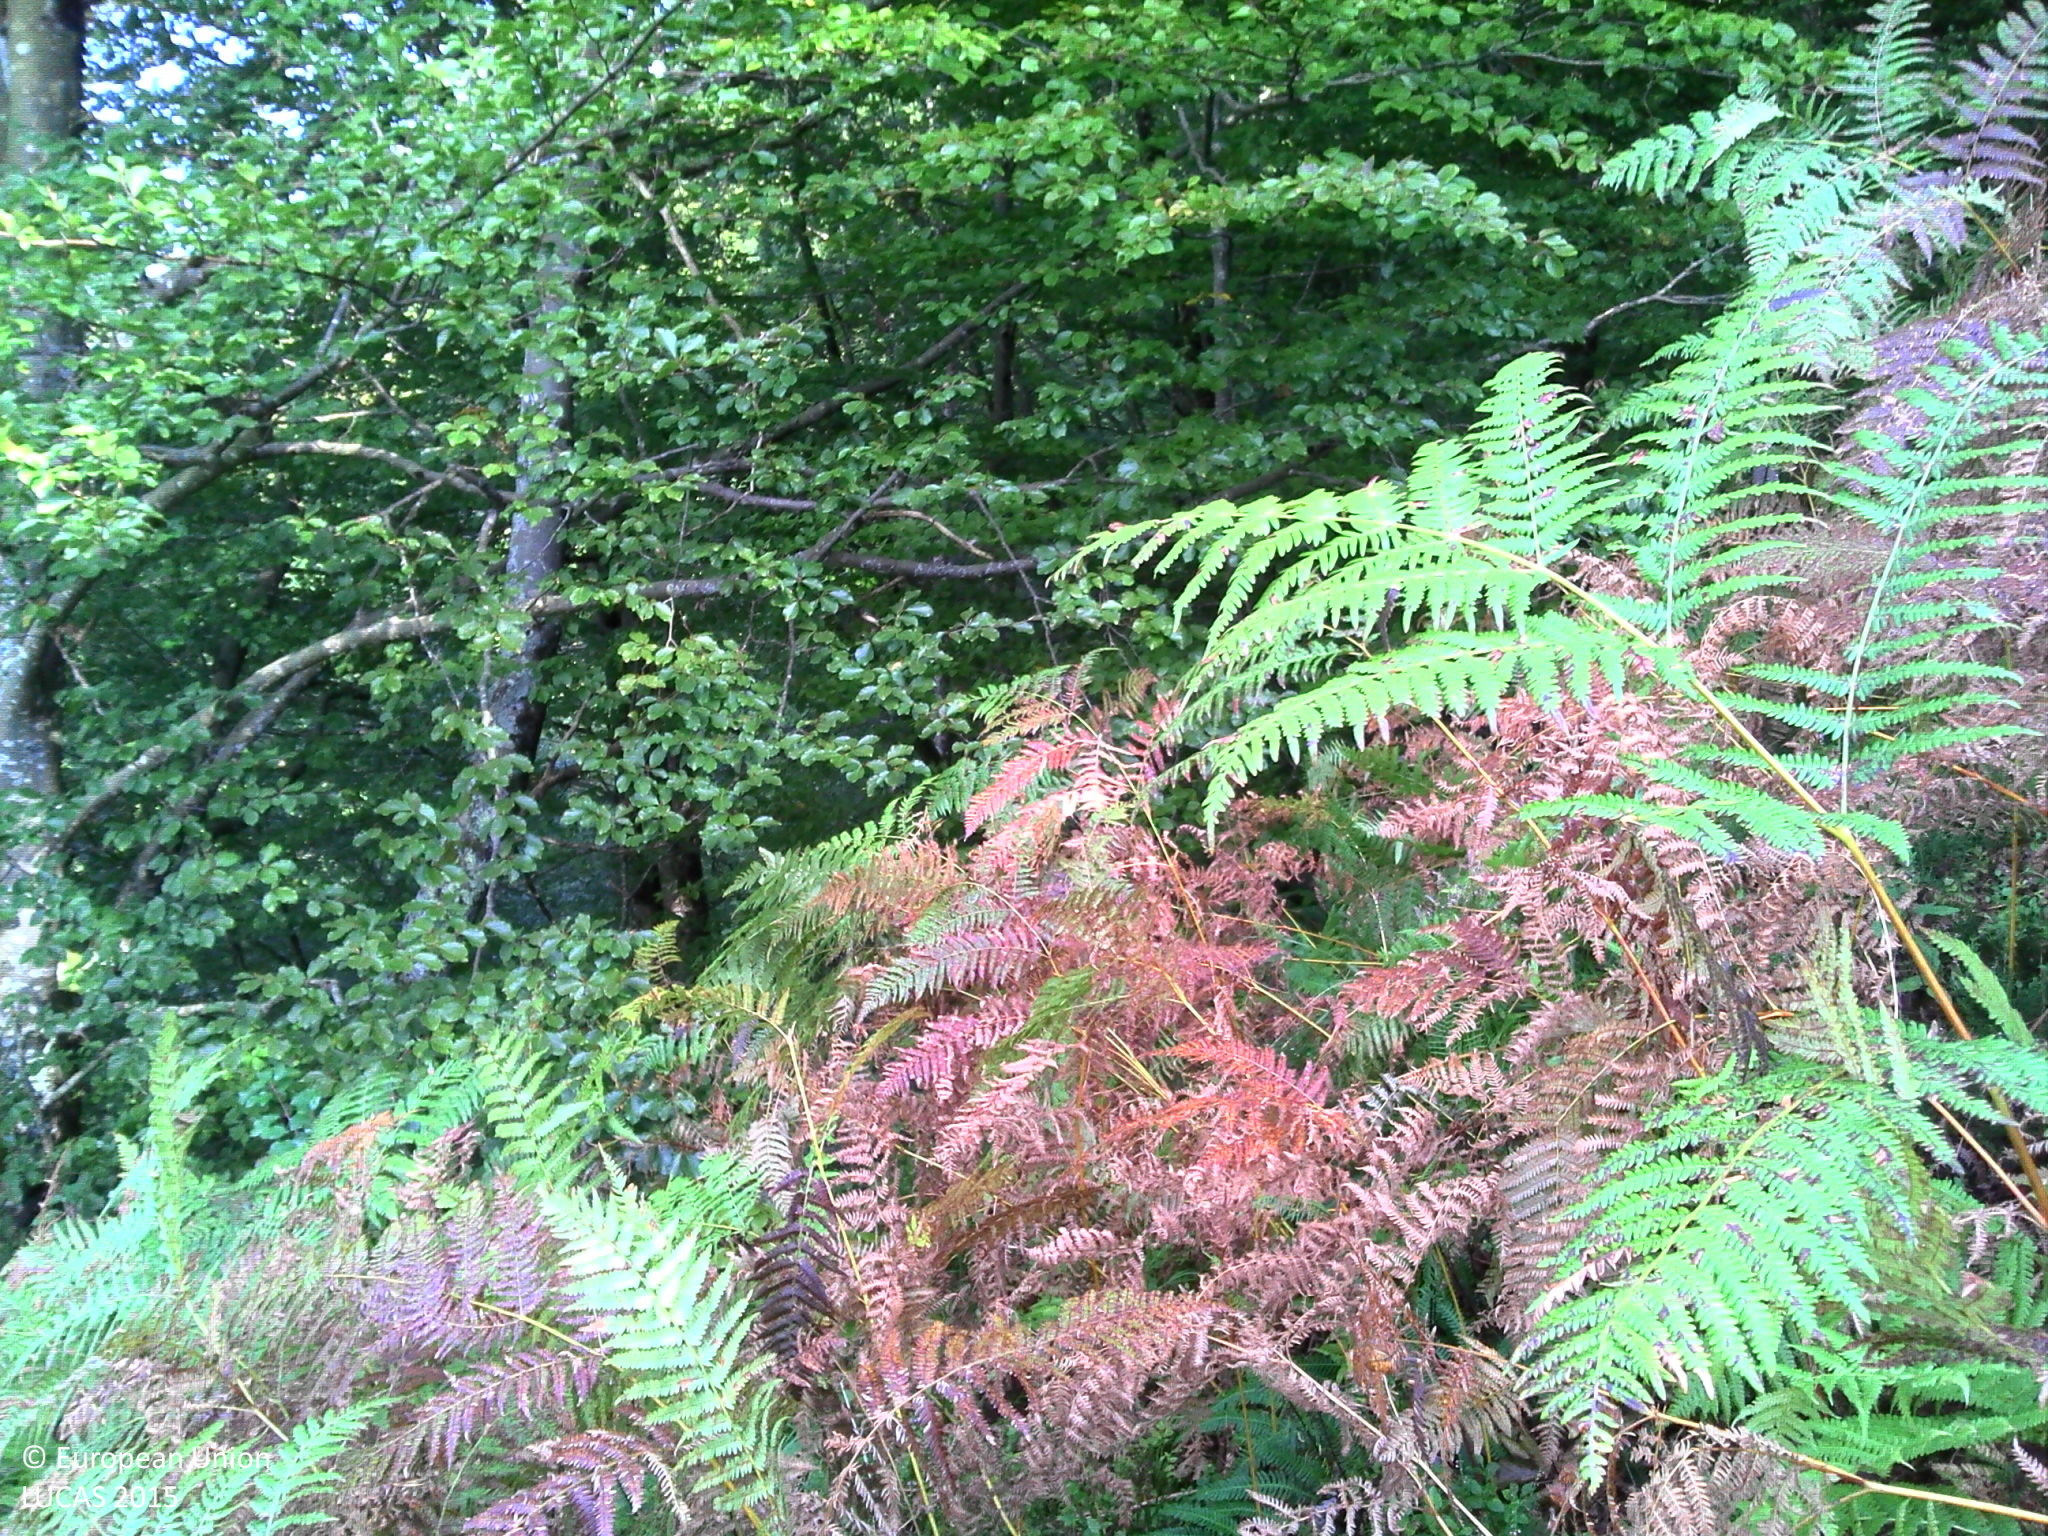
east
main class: Grassland
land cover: Spontaneously vegetated surfaces
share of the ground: > 75 %
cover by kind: herbaceous plants 95 %, shrubs 5 %
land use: Abandoned areas
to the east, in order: Spontaneously vegetated surfaces; Broadleaved woodland; Rivers and streams; Rocks and stones; Broadleaved woodland
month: September
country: FR
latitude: 43.0373
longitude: -0.6488
